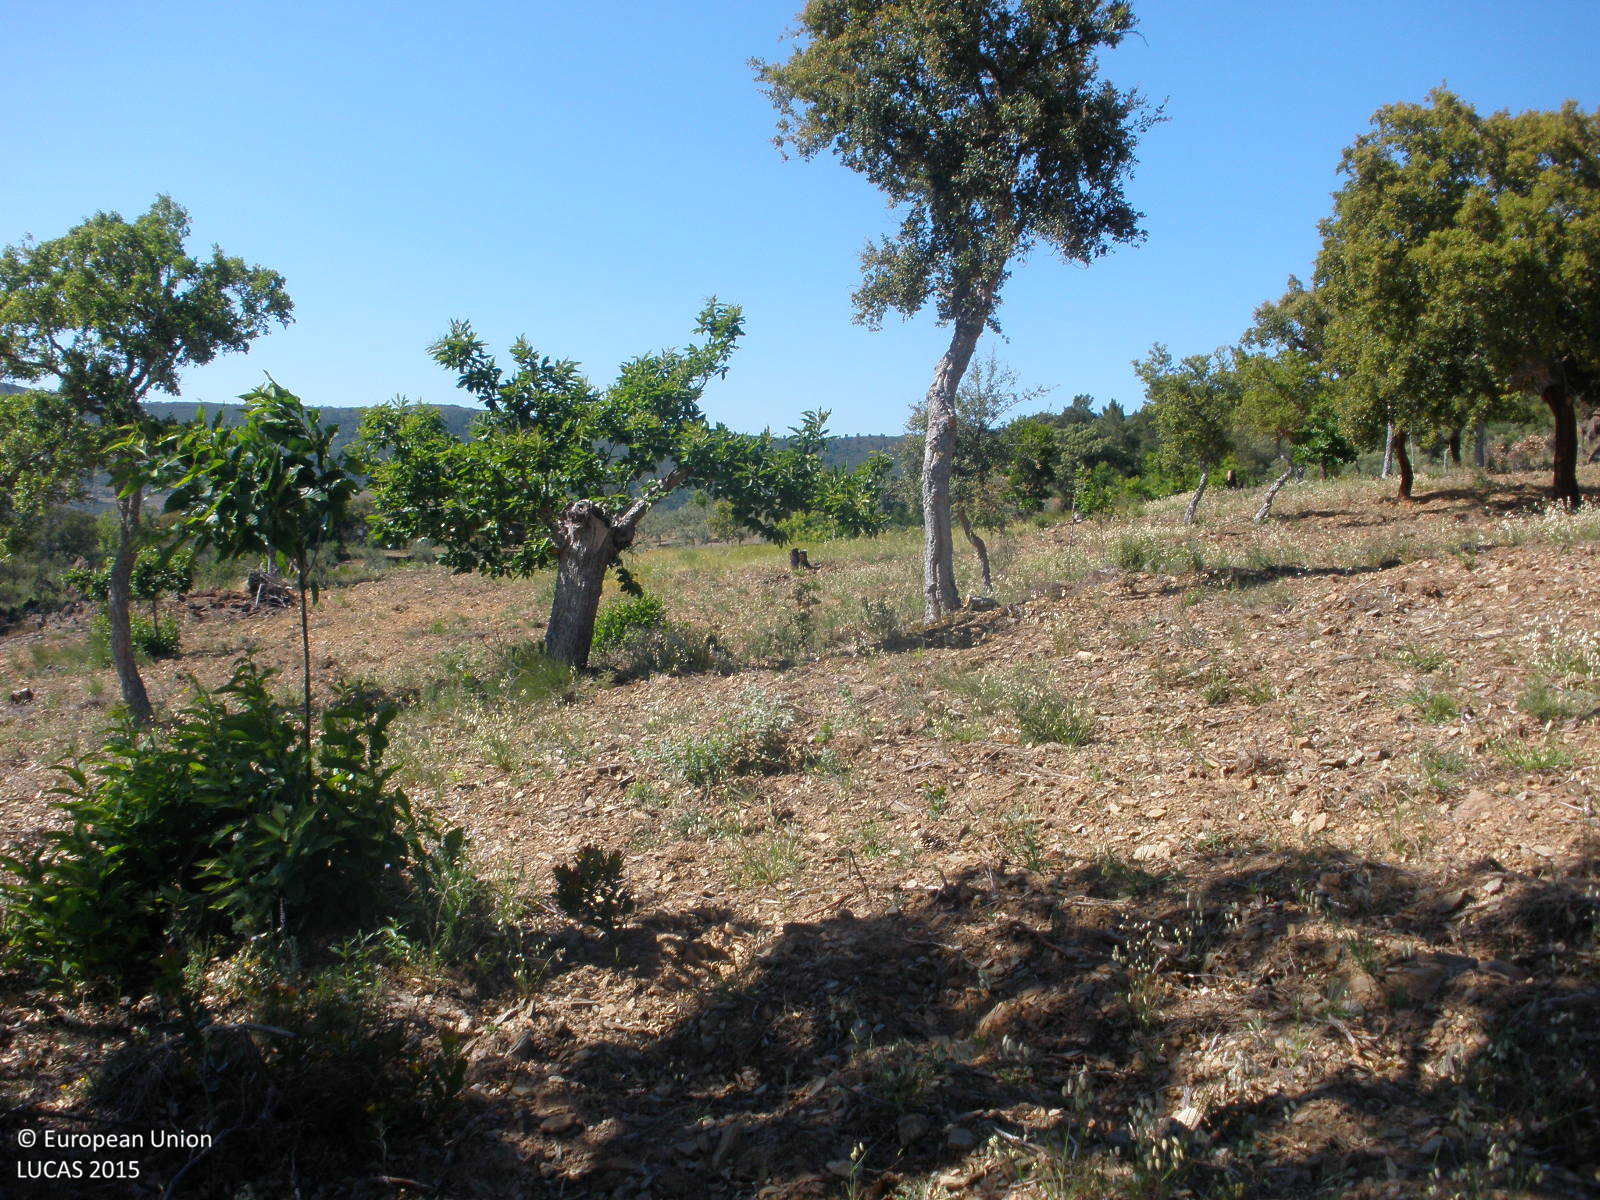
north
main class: Woodland
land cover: Broadleaved woodland
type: broadleaved evergreen forest
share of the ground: > 75 %
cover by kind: herbaceous plants 50 %, broadleaved forest trees 40 %, shrubs 10 %
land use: Forestry
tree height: < 5 m
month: May
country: ES
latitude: 40.2613
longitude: -6.2699
